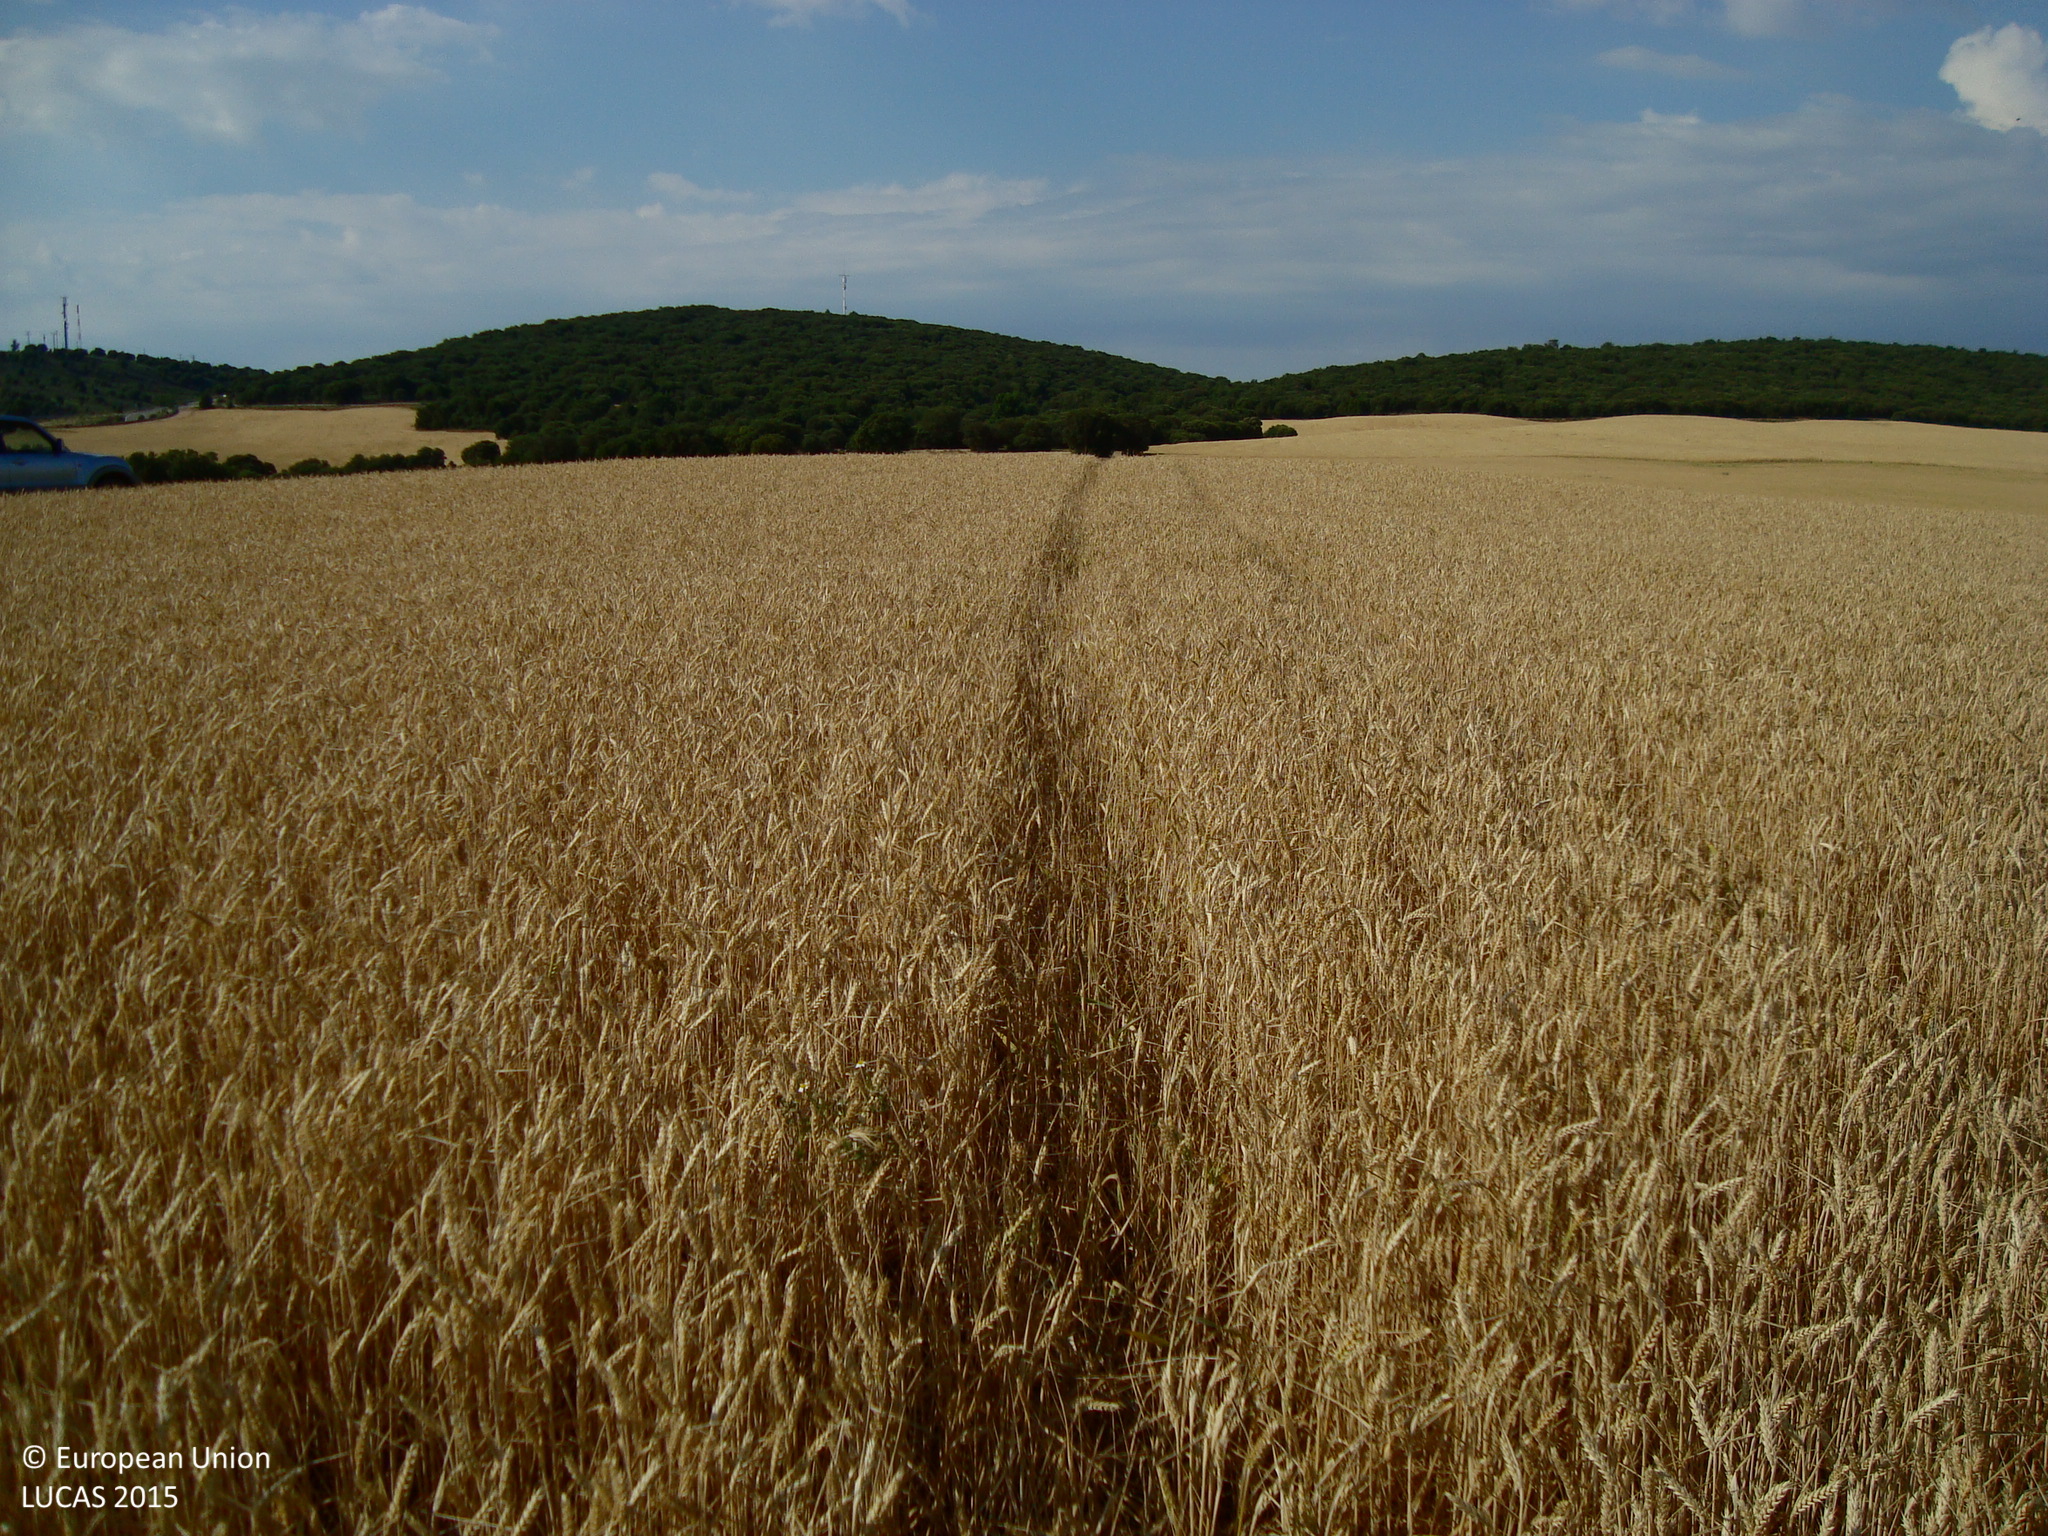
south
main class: Cropland
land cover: Common wheat
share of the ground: > 75 %
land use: Agriculture (excluding fallow land and kitchen gardens)
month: June
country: ES
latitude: 41.9815
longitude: -3.7805
